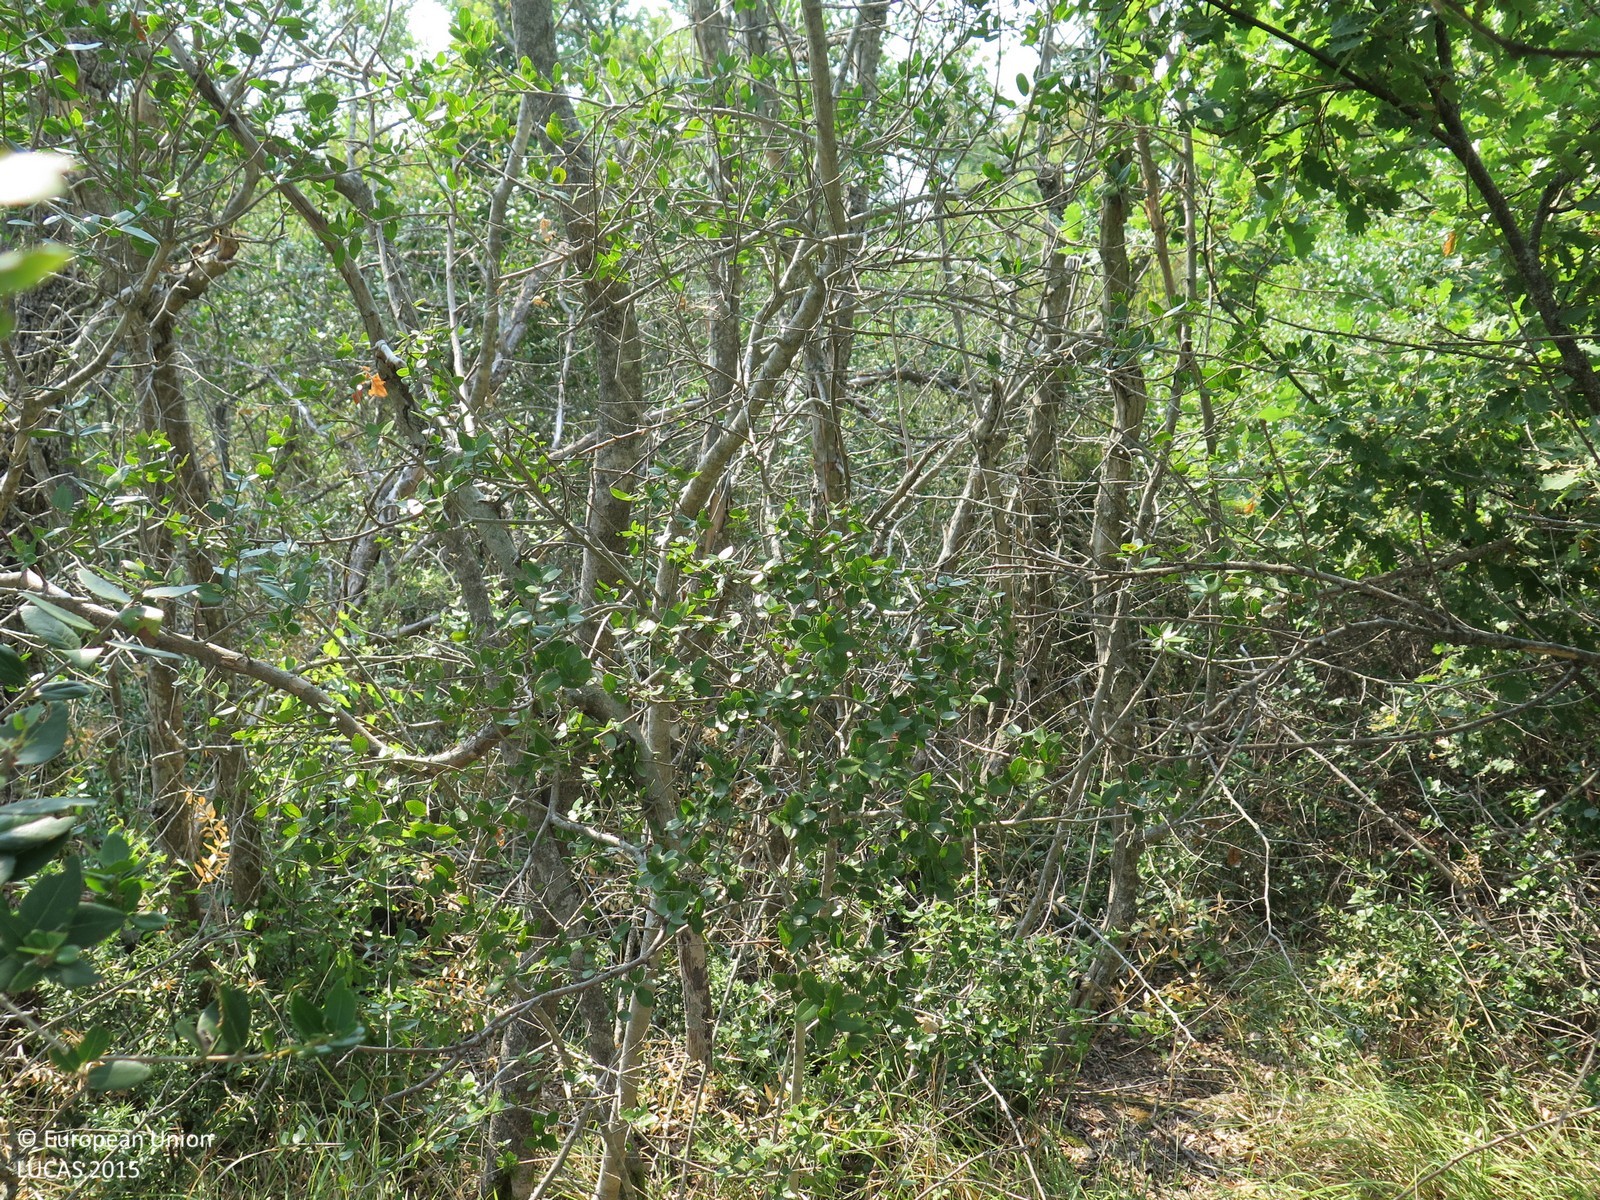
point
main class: Shrubland
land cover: Shrubland with sparse tree cover
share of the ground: > 75 %
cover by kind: shrubs 75 %, herbaceous plants 20 %, broadleaved forest trees 5 %
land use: Semi-natural and natural areas not in use
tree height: < 5 m
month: July
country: HR
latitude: 45.0044
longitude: 13.7624
